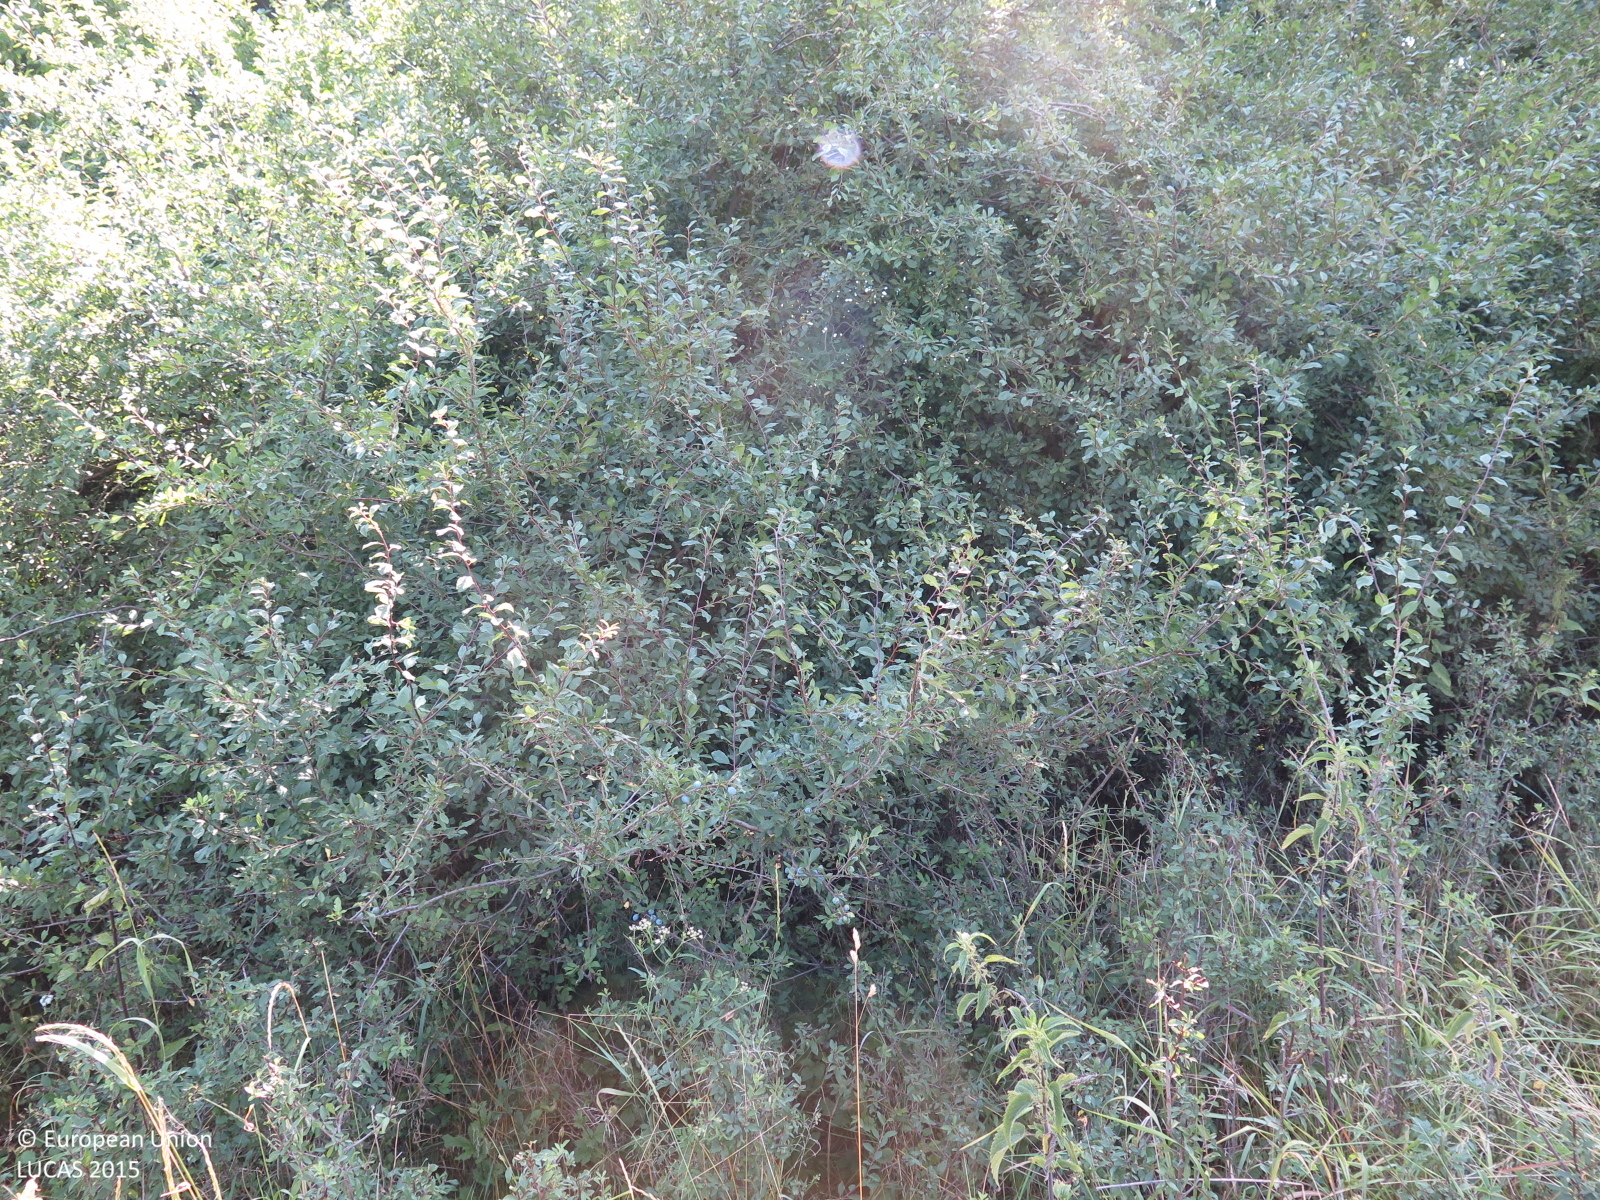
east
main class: Grassland
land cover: Spontaneously vegetated surfaces
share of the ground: > 75 %
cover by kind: herbaceous plants 95 %, shrubs 5 %
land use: Fallow land
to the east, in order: Spontaneously vegetated surfaces; Shrubland with sparse tree cover; Broadleaved woodland; Clovers; Tracks; Grassland without tree/shrub cover; Broadleaved woodland; Ditches and canals; Broadleaved woodland; Rivers and streams; Broadleaved woodland; Apple fruit
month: July
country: CZ
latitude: 49.0307
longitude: 17.5479
